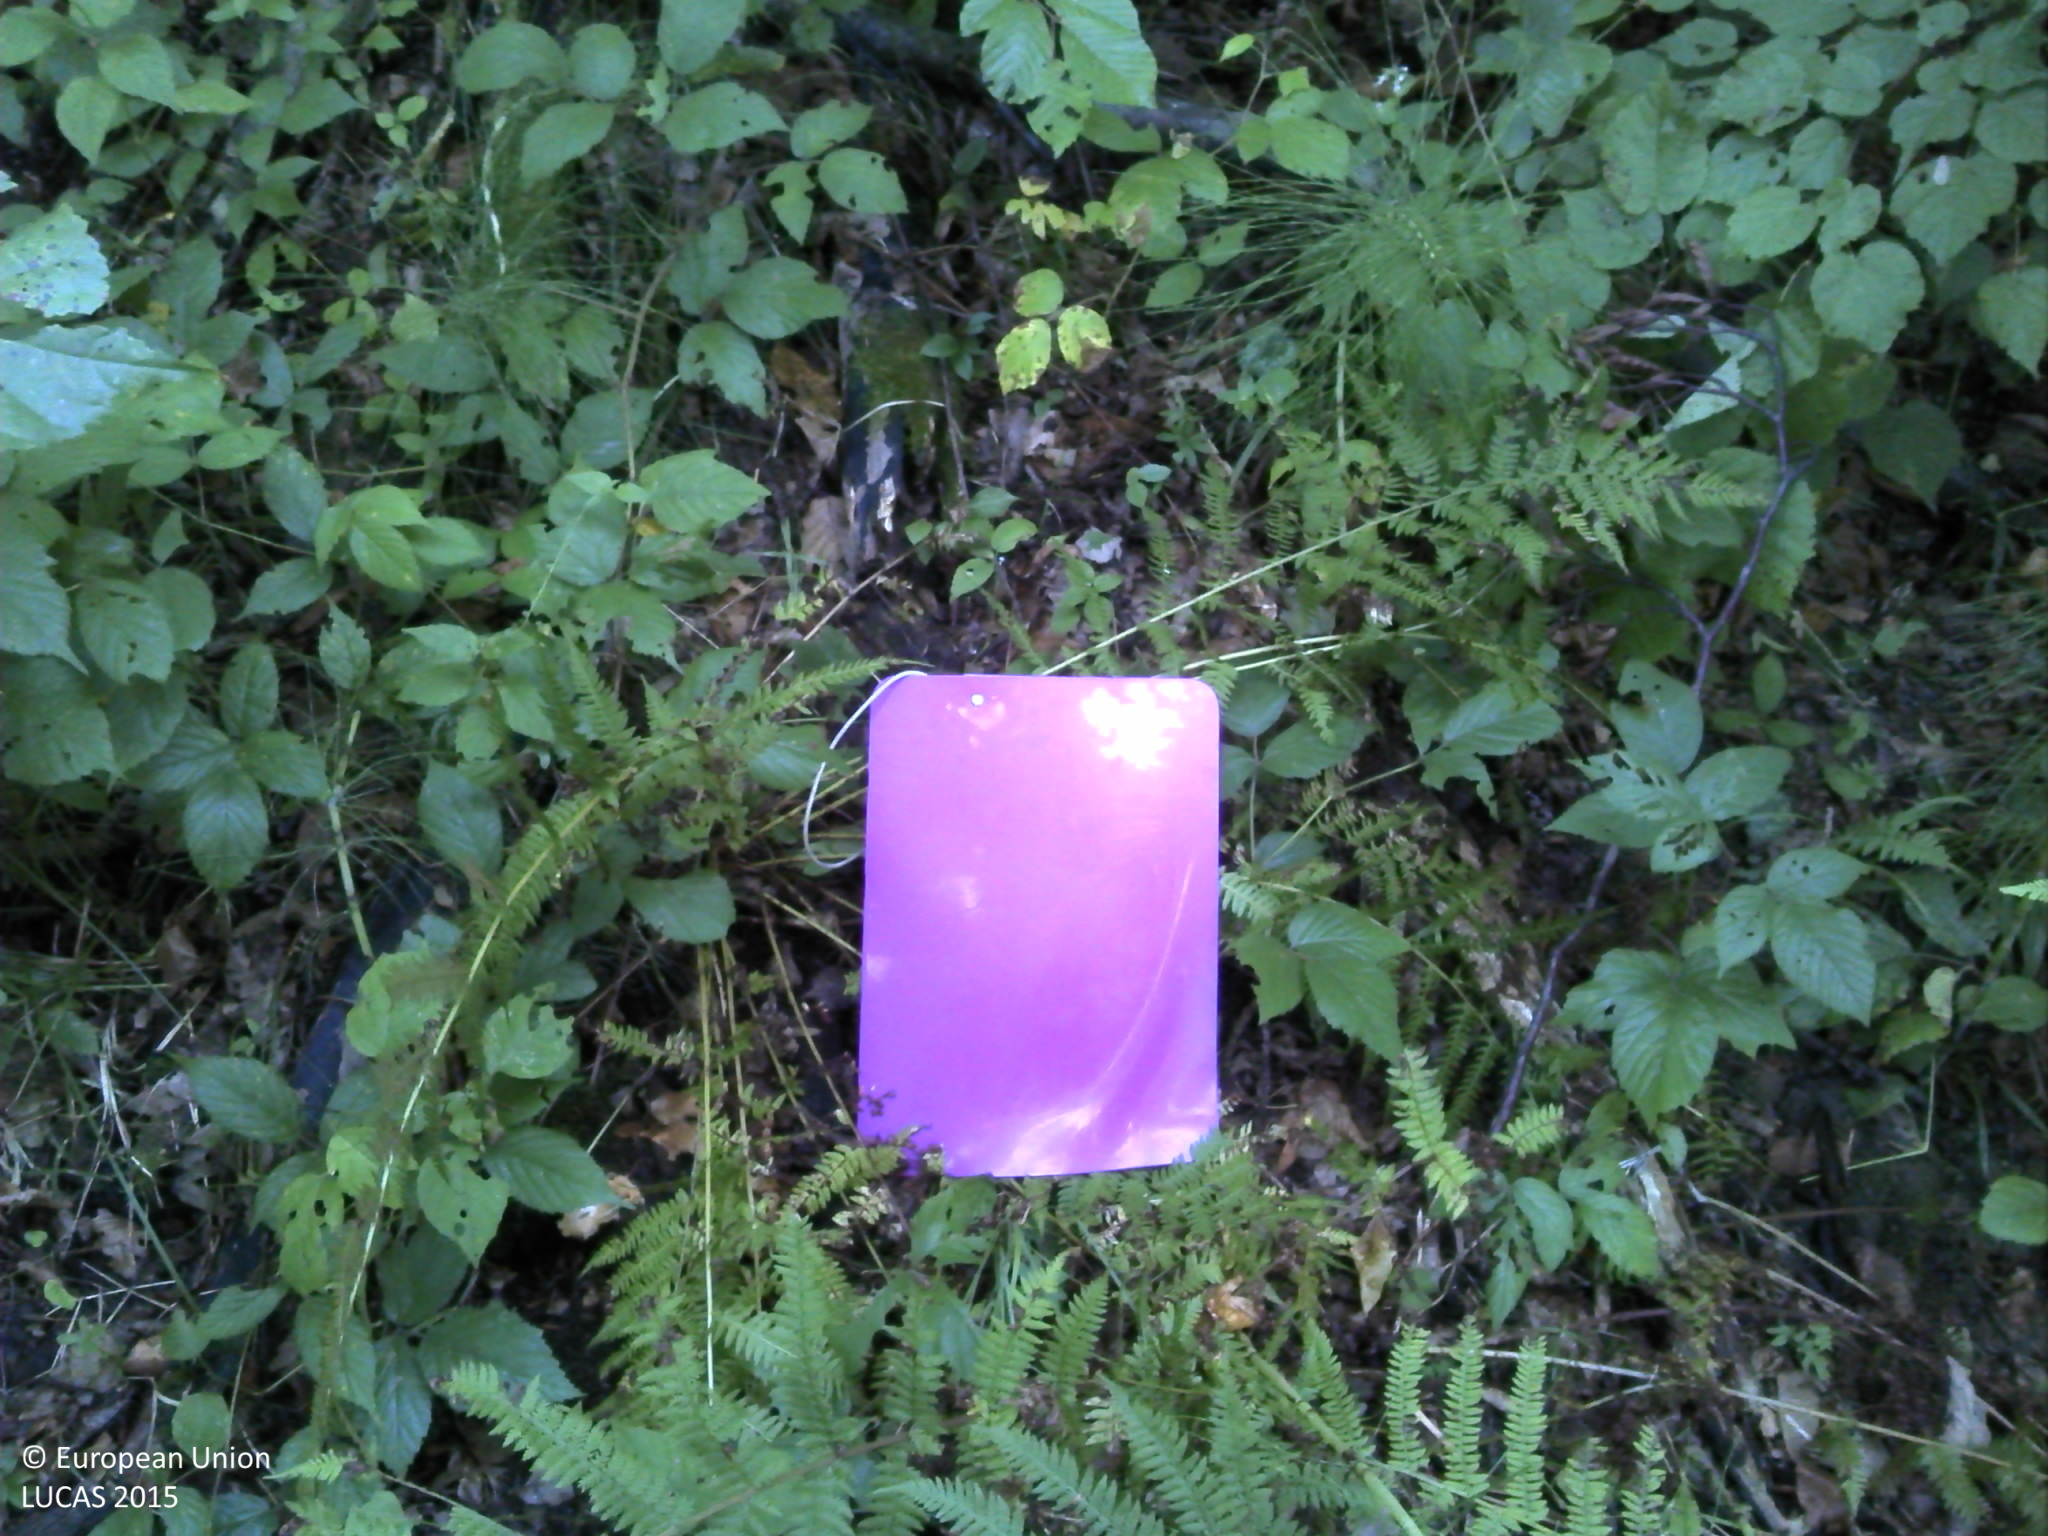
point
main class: Woodland
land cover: Broadleaved woodland
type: beech forest
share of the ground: > 75 %
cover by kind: broadleaved forest trees 100 %
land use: Forestry
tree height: > 5 m
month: August
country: HR
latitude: 45.3031
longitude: 16.5145
